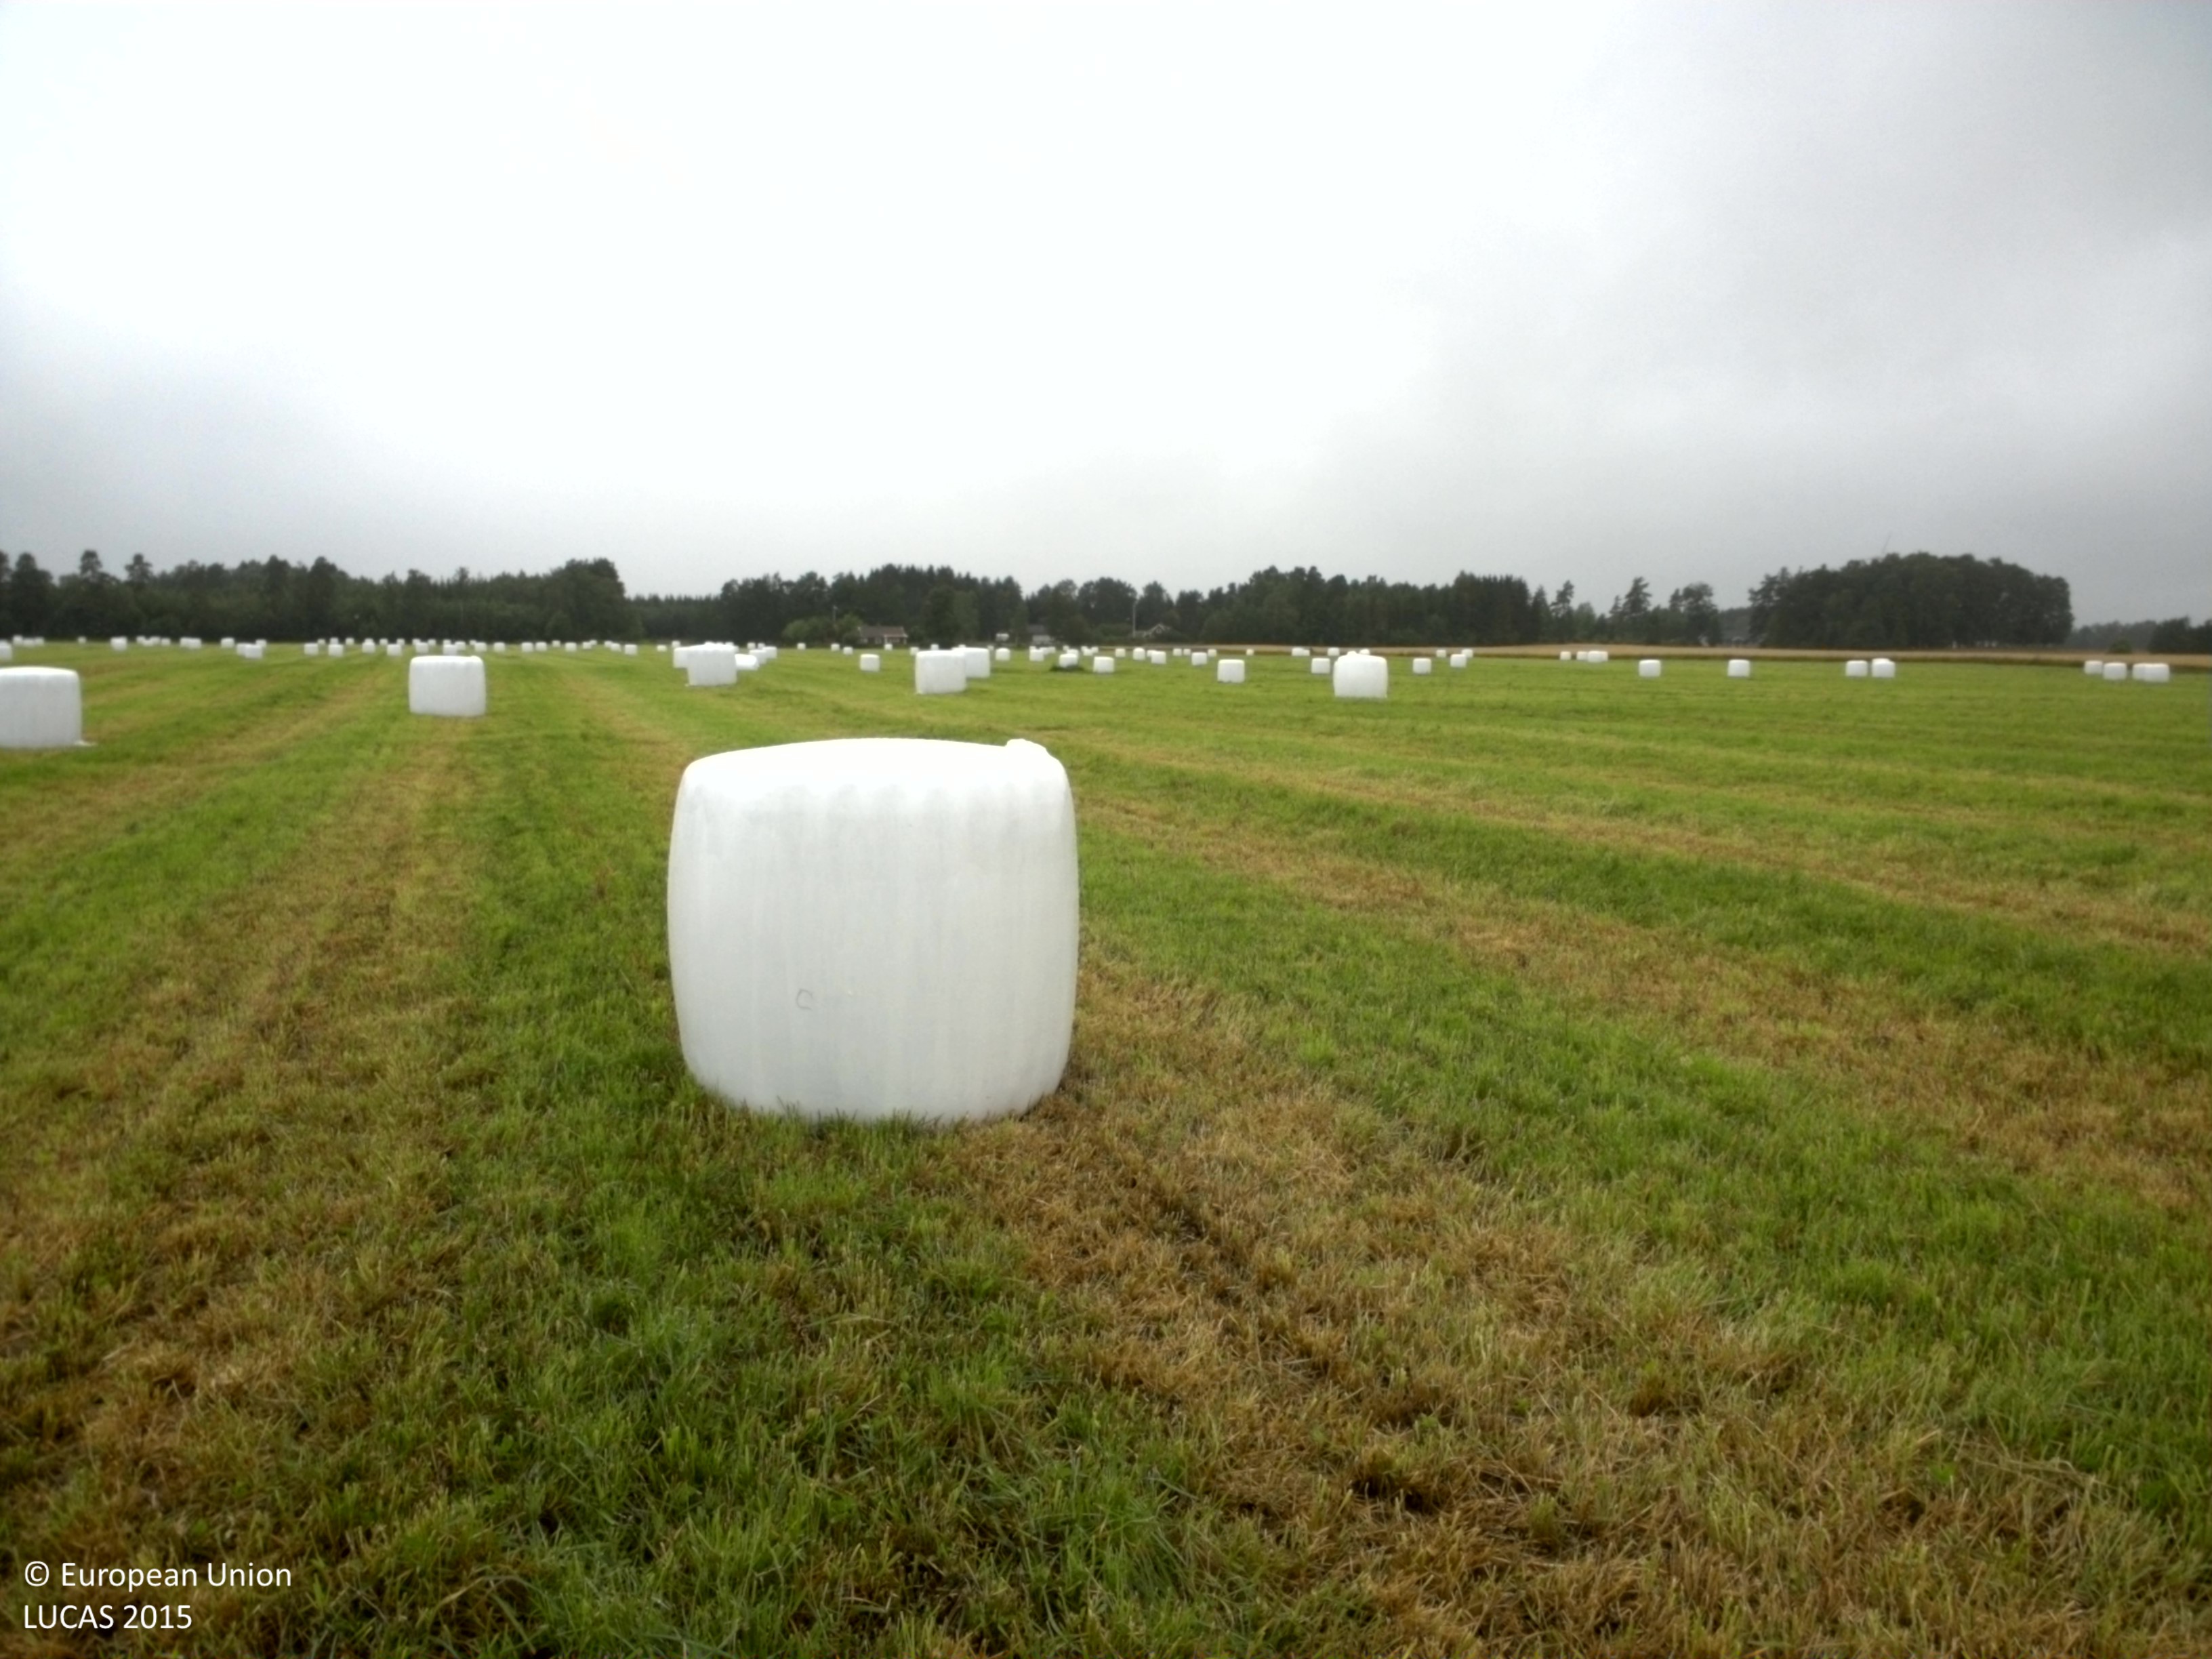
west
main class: Cropland
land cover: Other leguminous and mixtures for fodder
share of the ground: > 75 %
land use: Agriculture (excluding fallow land and kitchen gardens)
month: July
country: SE
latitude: 58.4653
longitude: 13.3711
